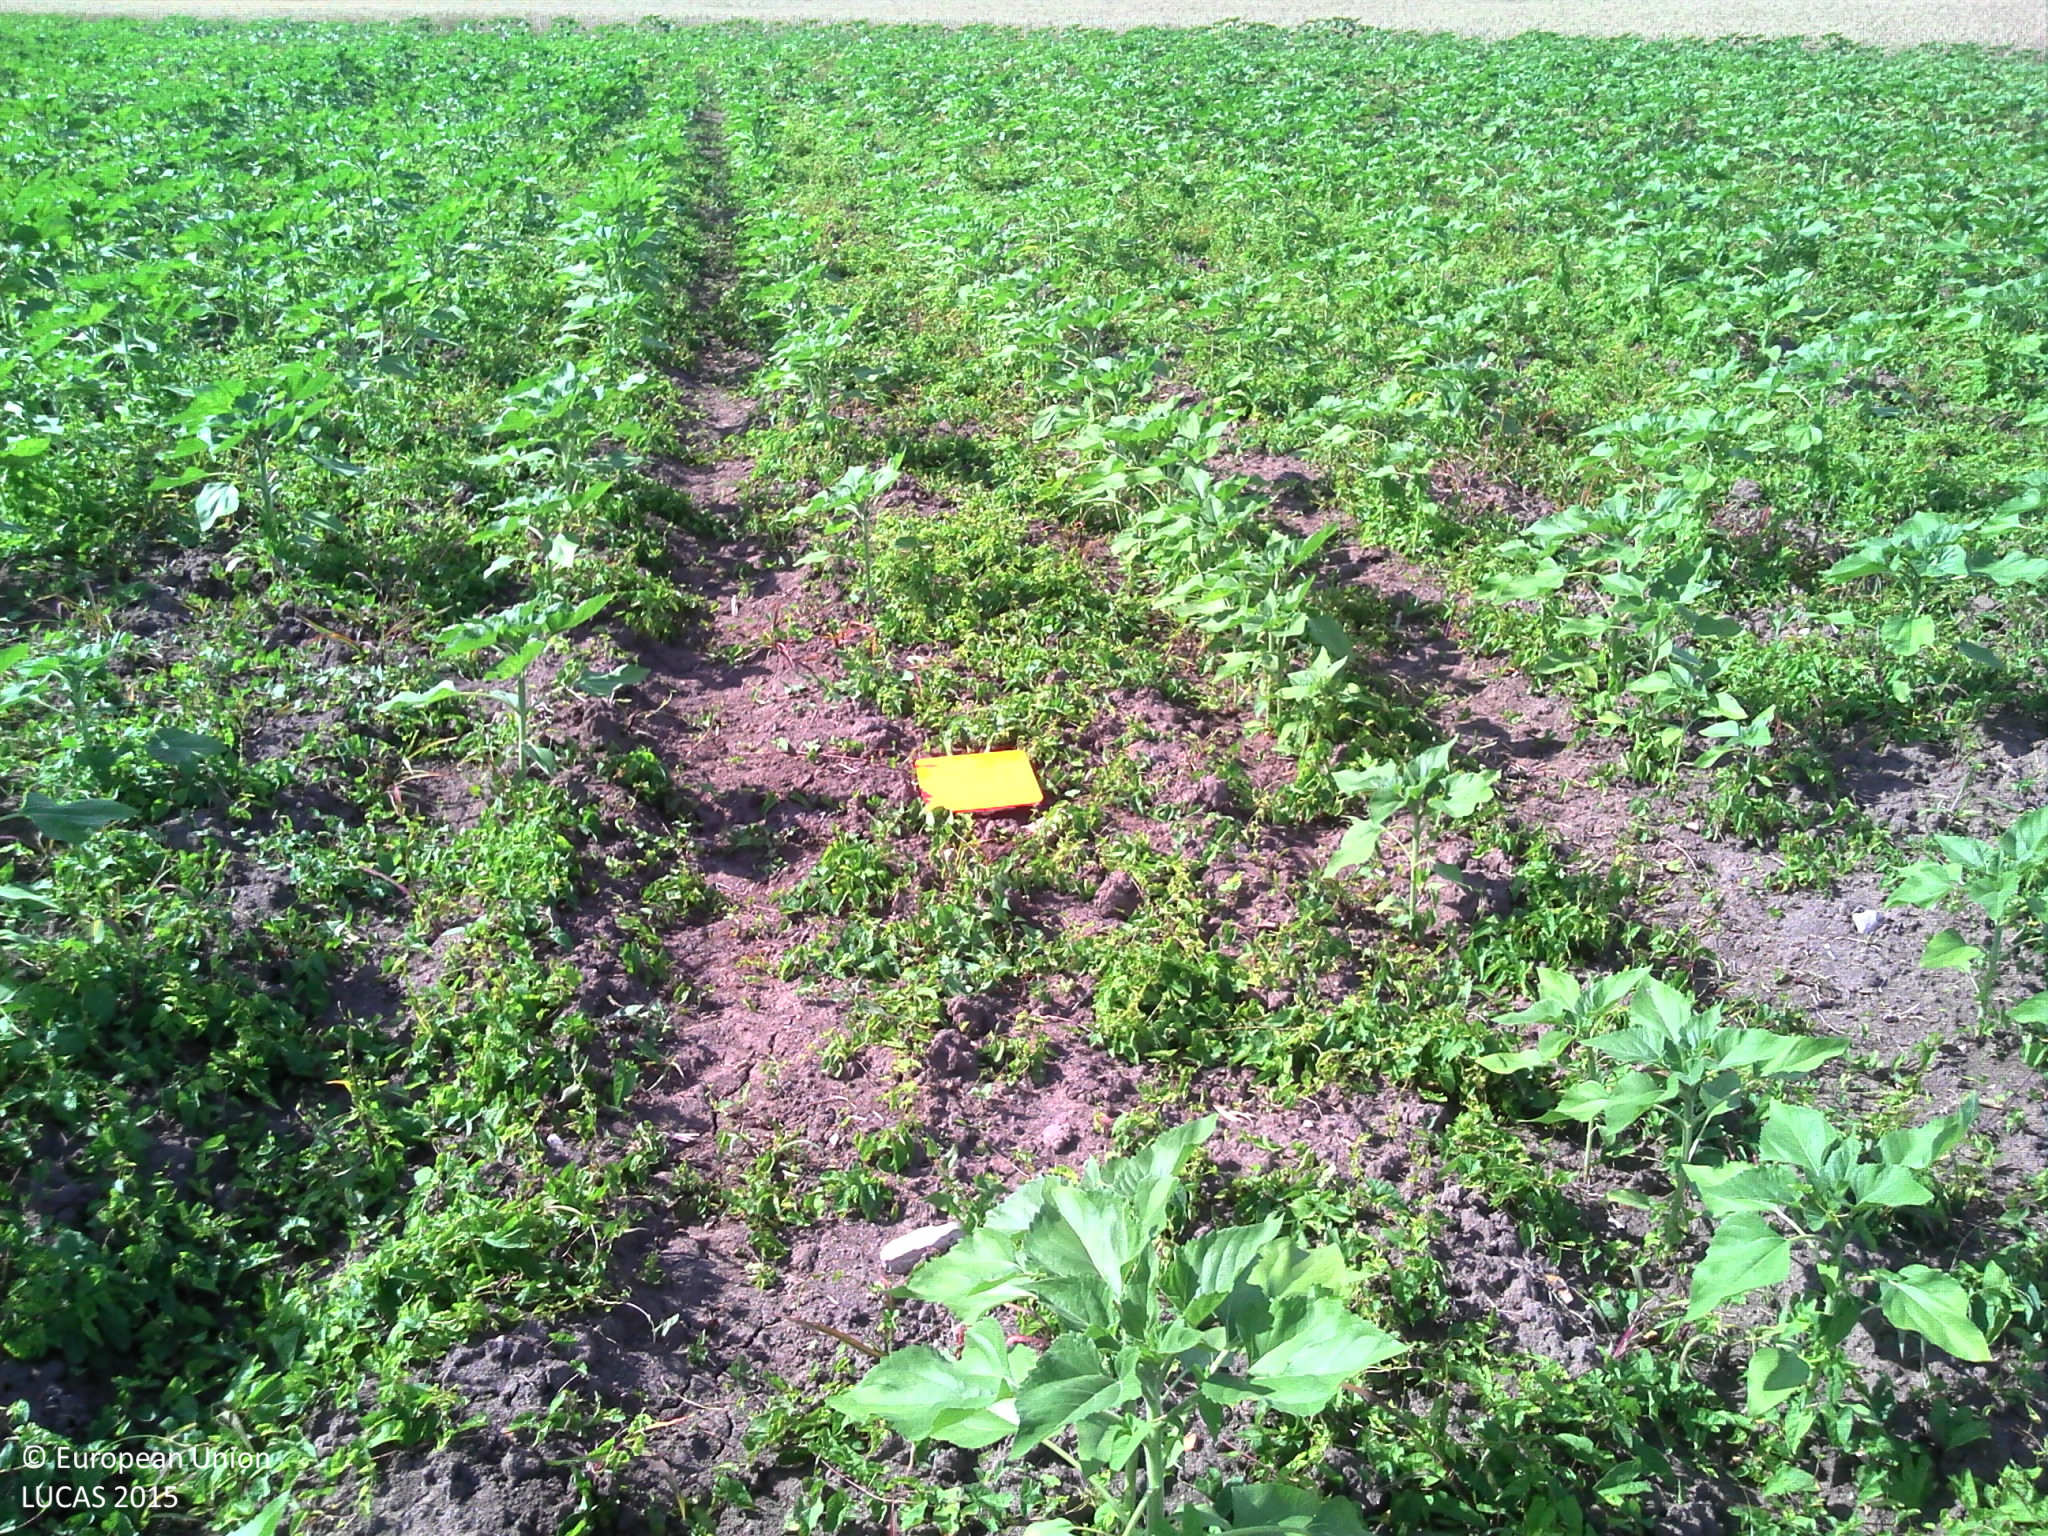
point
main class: Cropland
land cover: Sunflower
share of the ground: 50 - 75 %
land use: Agriculture (excluding fallow land and kitchen gardens)
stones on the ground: < 10 %
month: June
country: FR
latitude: 46.8140
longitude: 0.4794
